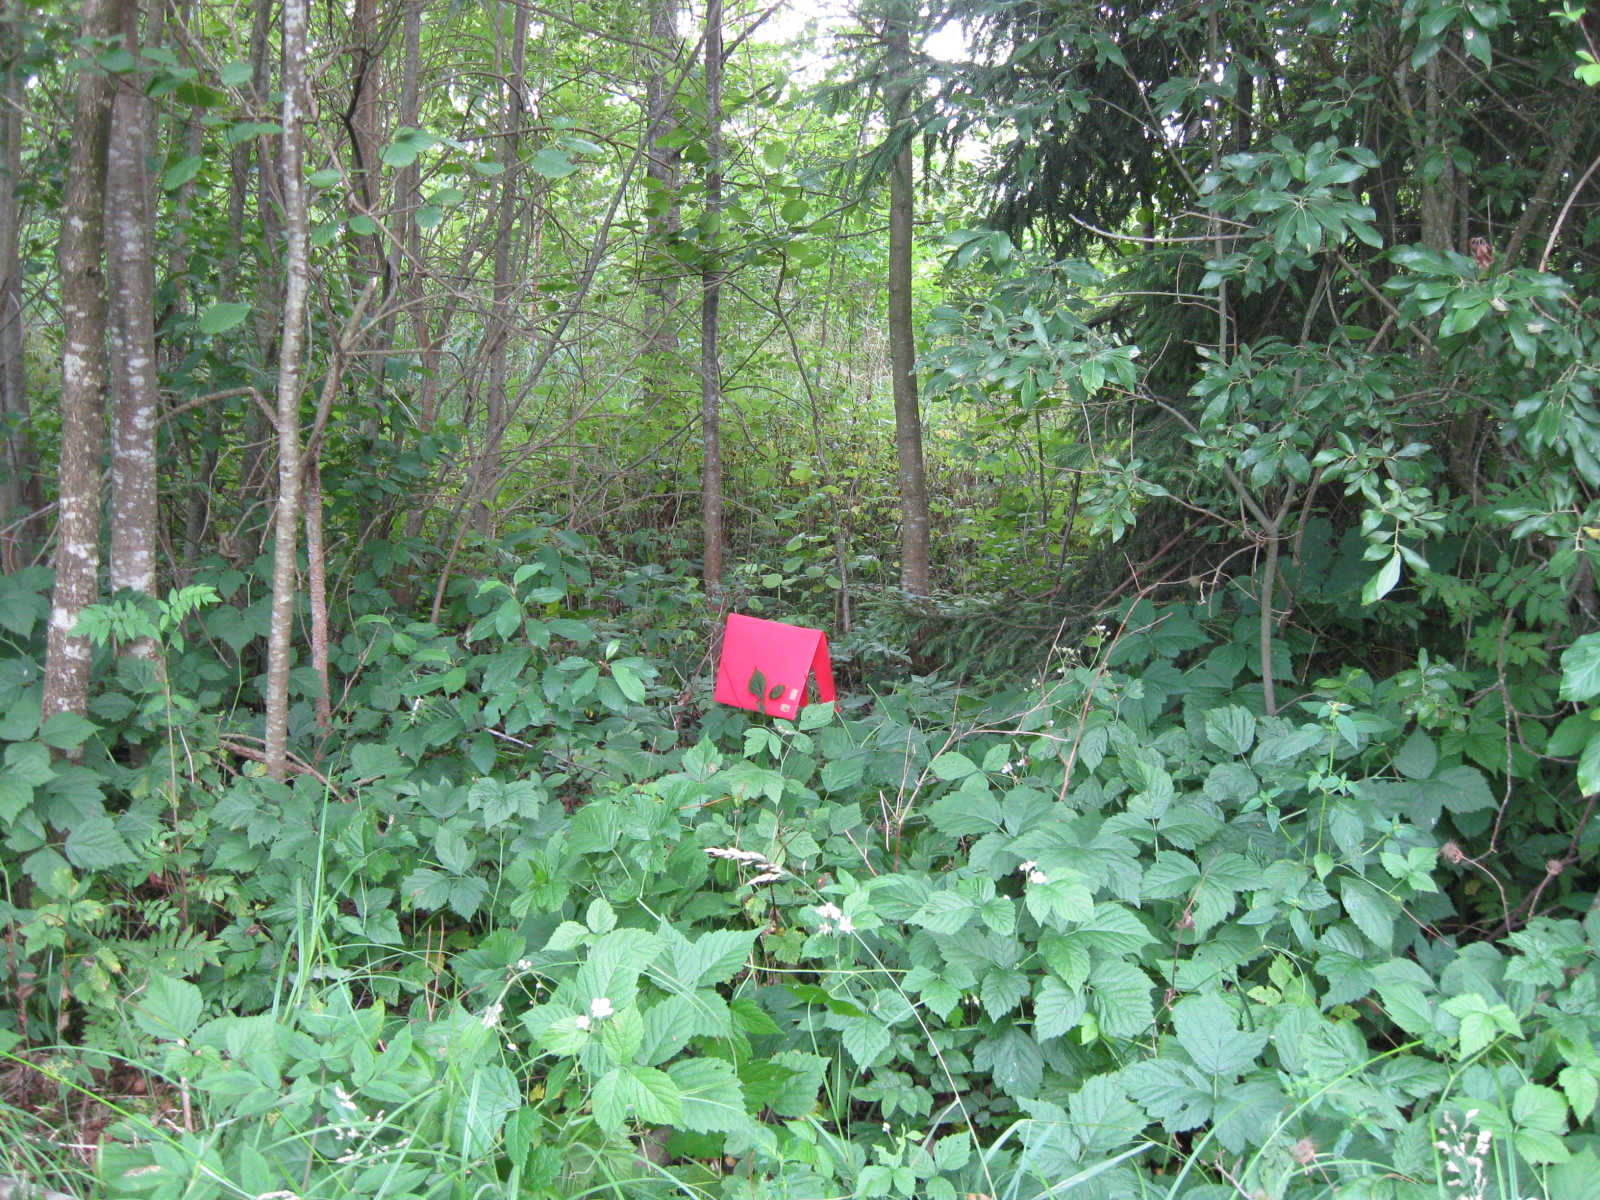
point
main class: Woodland
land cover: Broadleaved woodland
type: non-riverine alder, birch or aspen forest
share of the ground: > 75 %
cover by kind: broadleaved forest trees 80 %, herbaceous plants 15 %, coniferous forest trees 5 %
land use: Forestry
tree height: > 5 m
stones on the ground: < 10 %
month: July
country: LT
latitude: 54.6933
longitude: 23.7550
